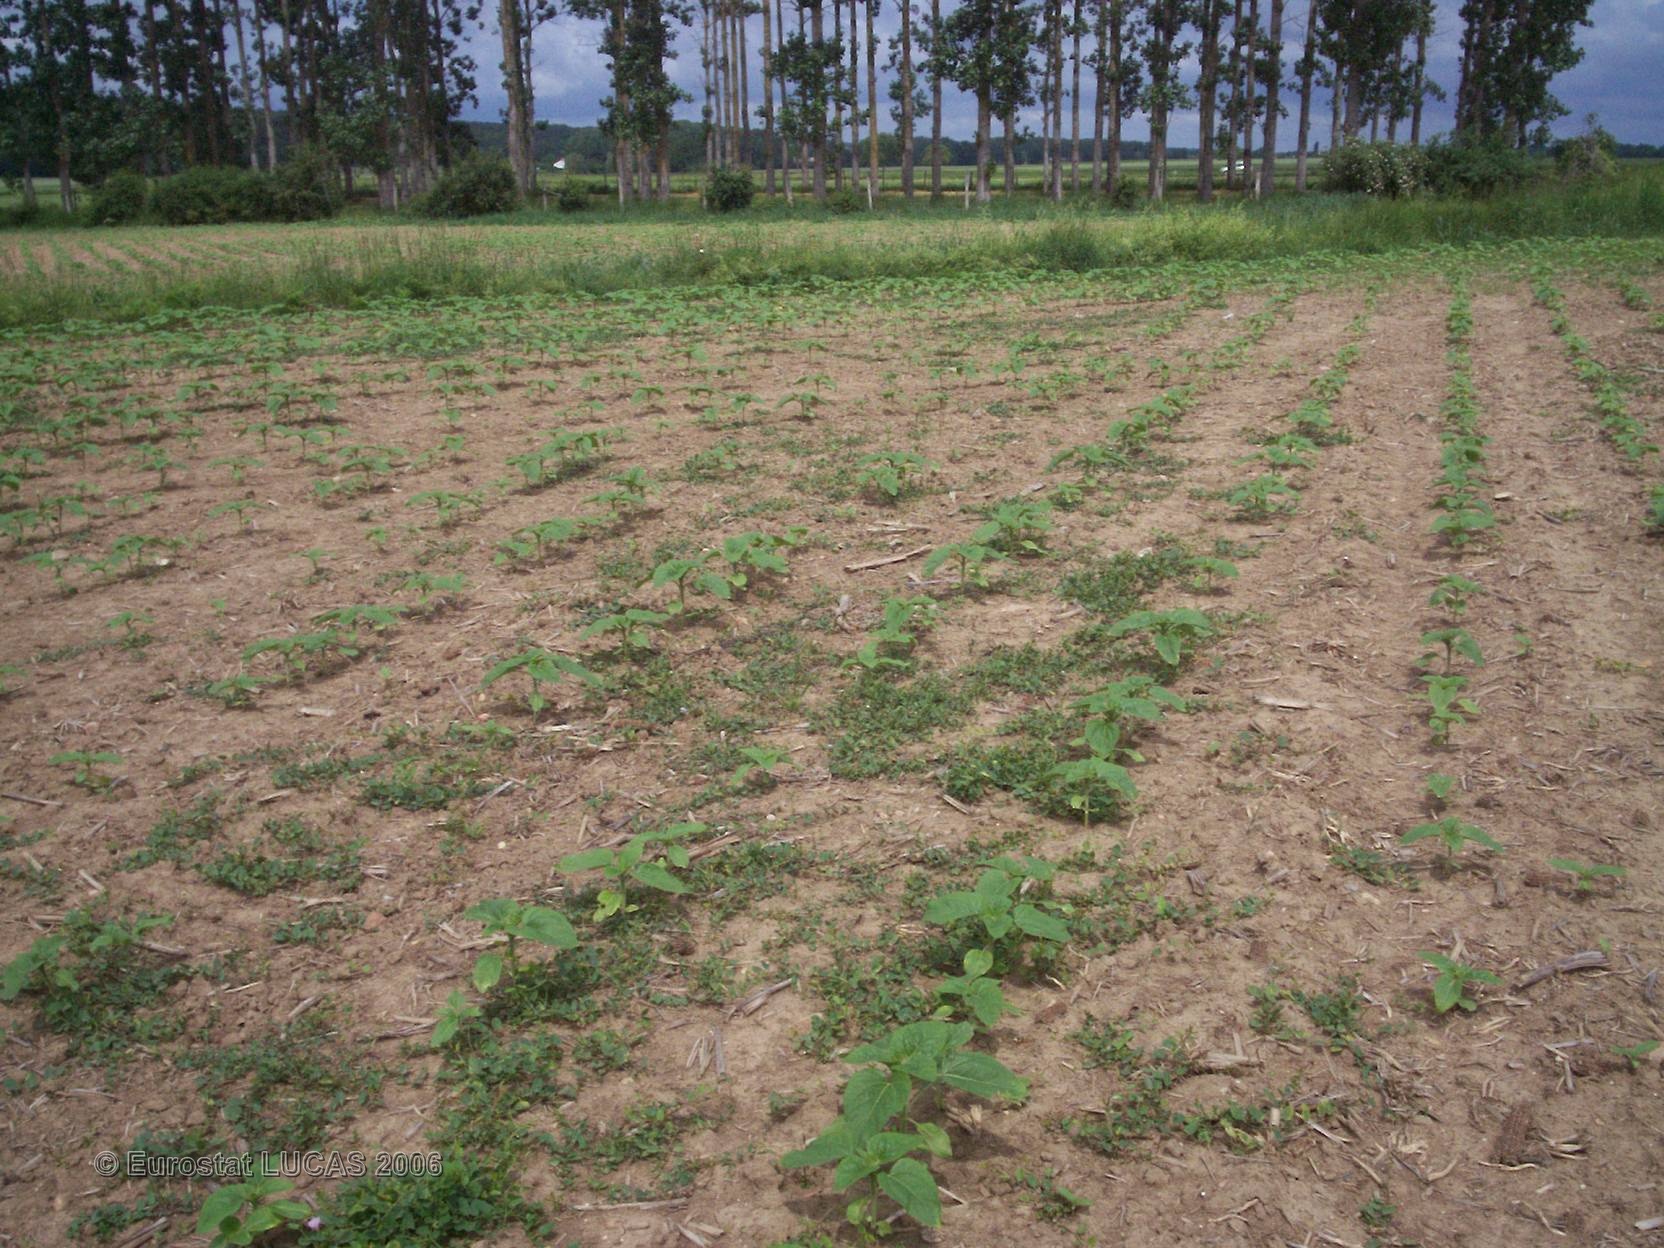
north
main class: Cropland
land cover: Sunflower
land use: Agriculture (excluding fallow land and kitchen gardens)
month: May
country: FR
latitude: 46.6937
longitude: 0.5539
